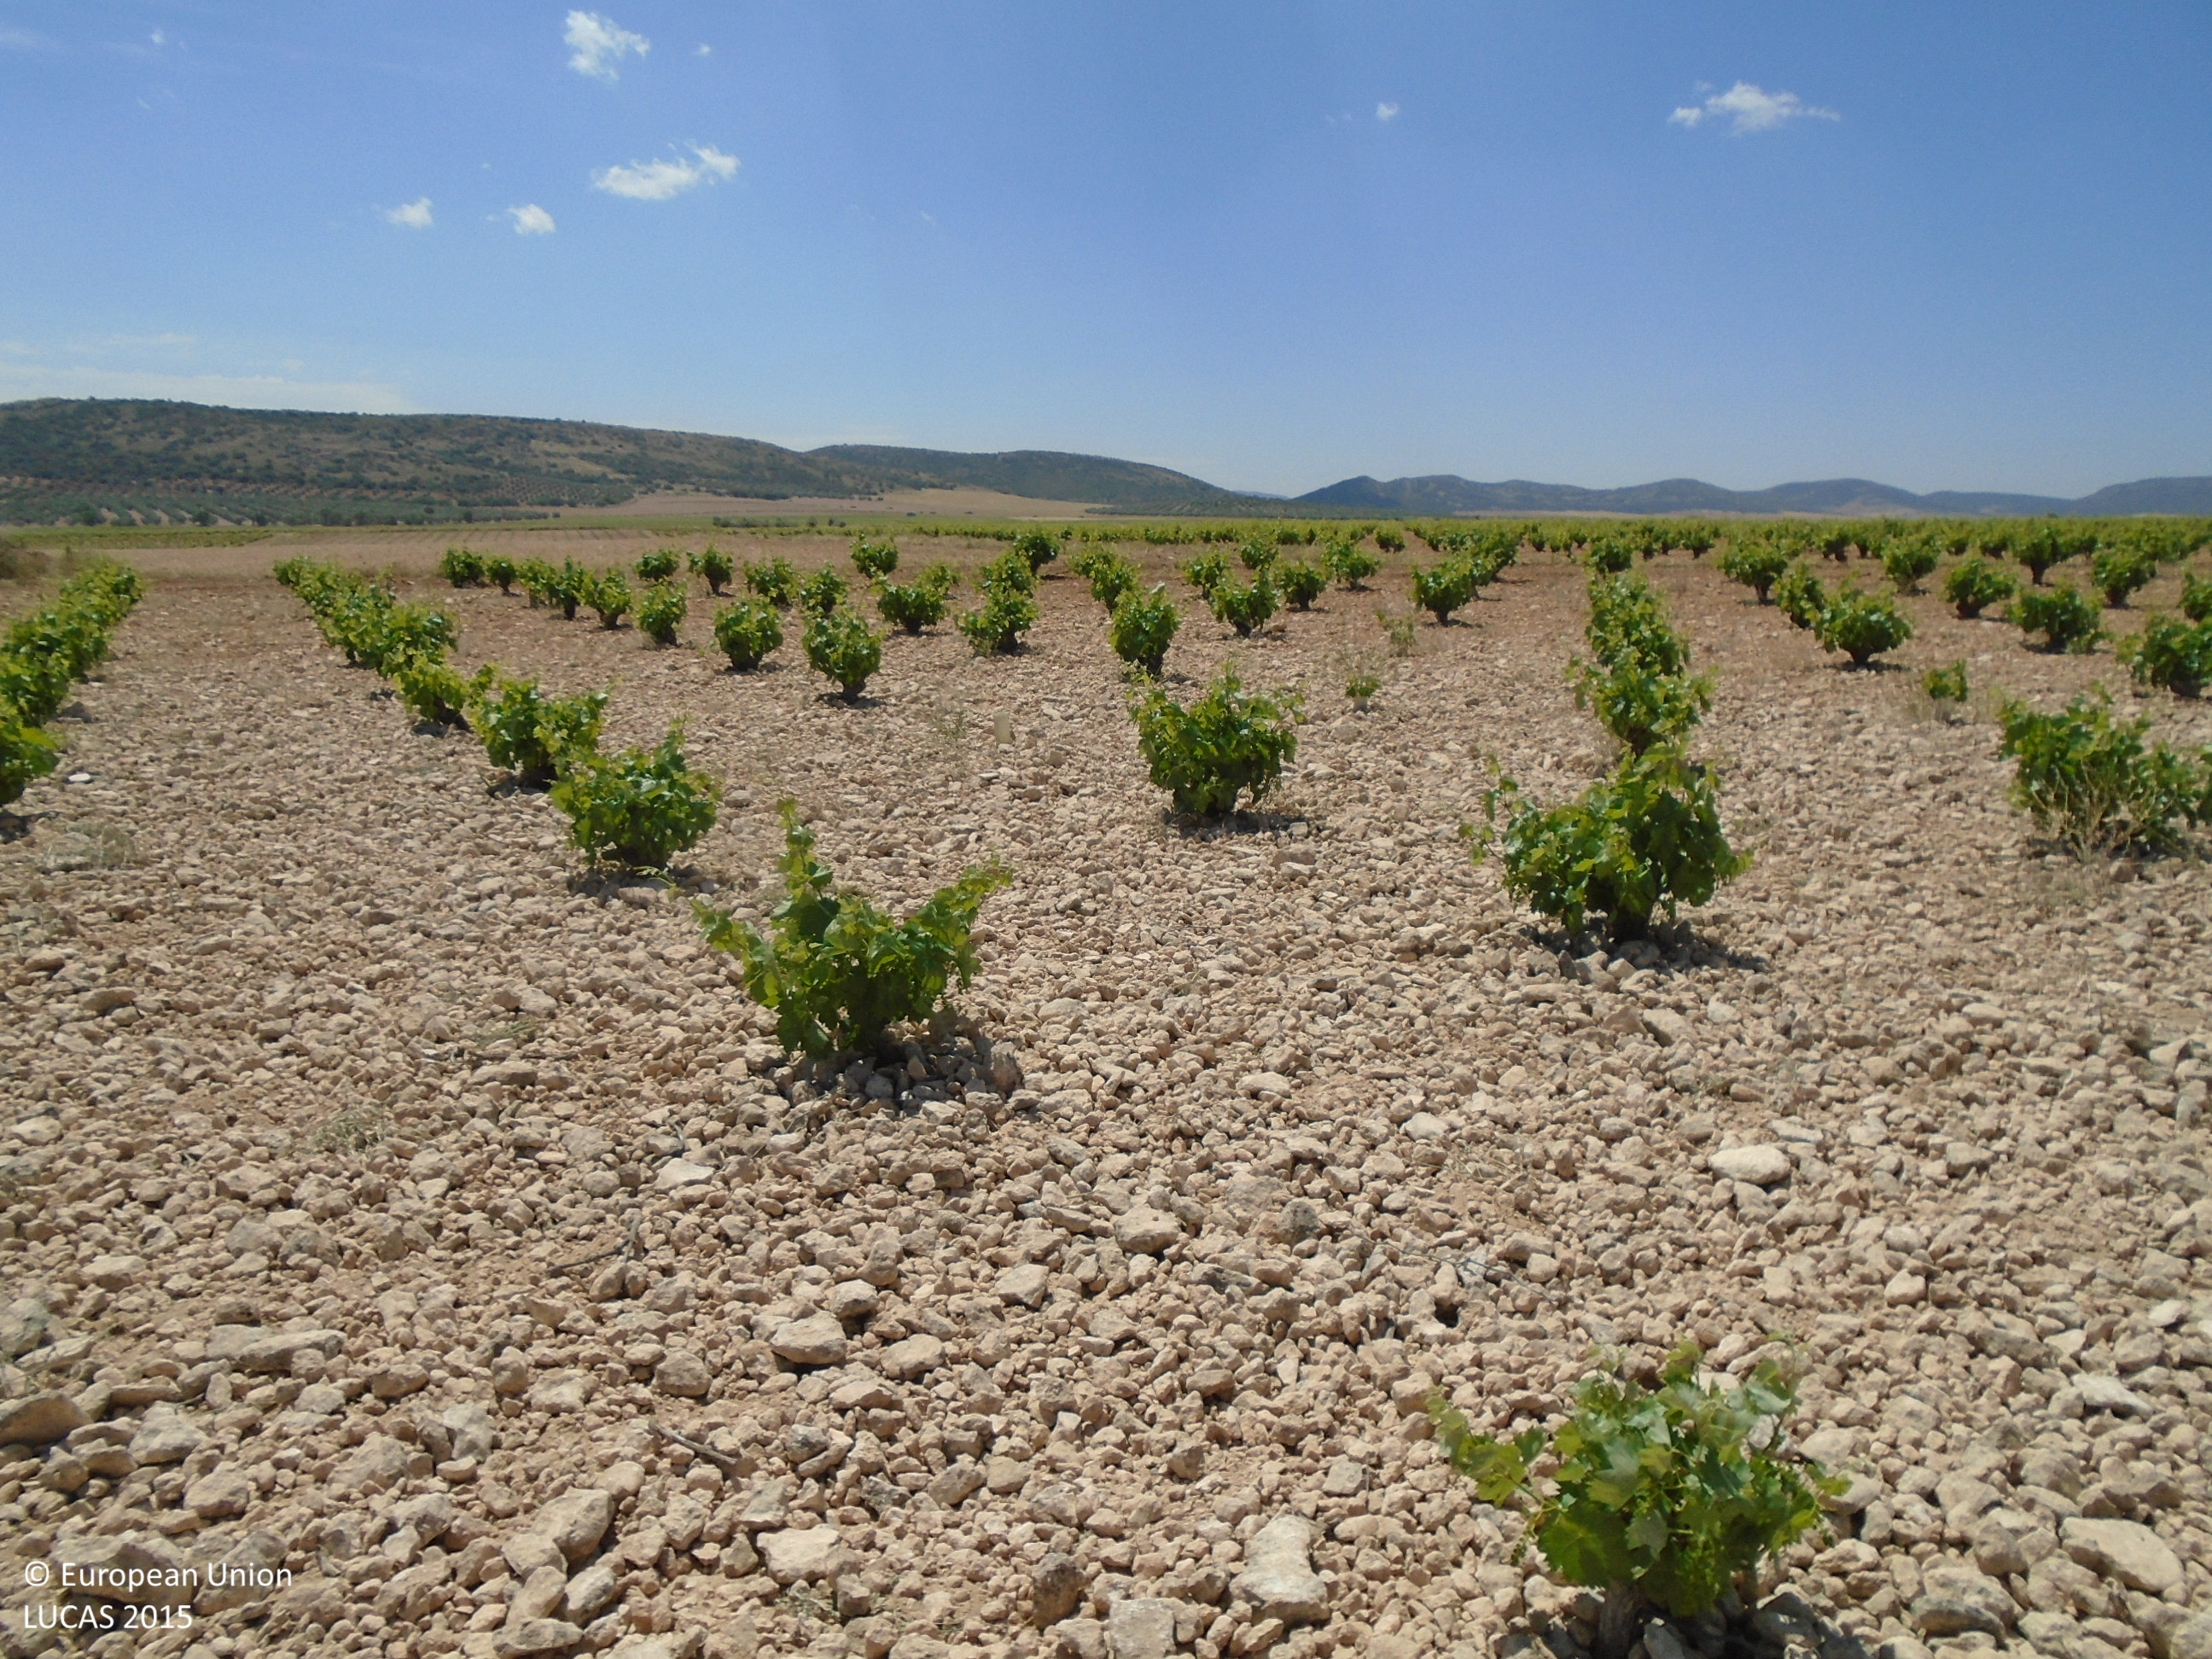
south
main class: Cropland
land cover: Vineyards
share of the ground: 10 - 25 %
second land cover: Other bare soil
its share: > 75 %
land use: Agriculture (excluding fallow land and kitchen gardens)
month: May
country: ES
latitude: 39.5253
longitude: -3.6708
